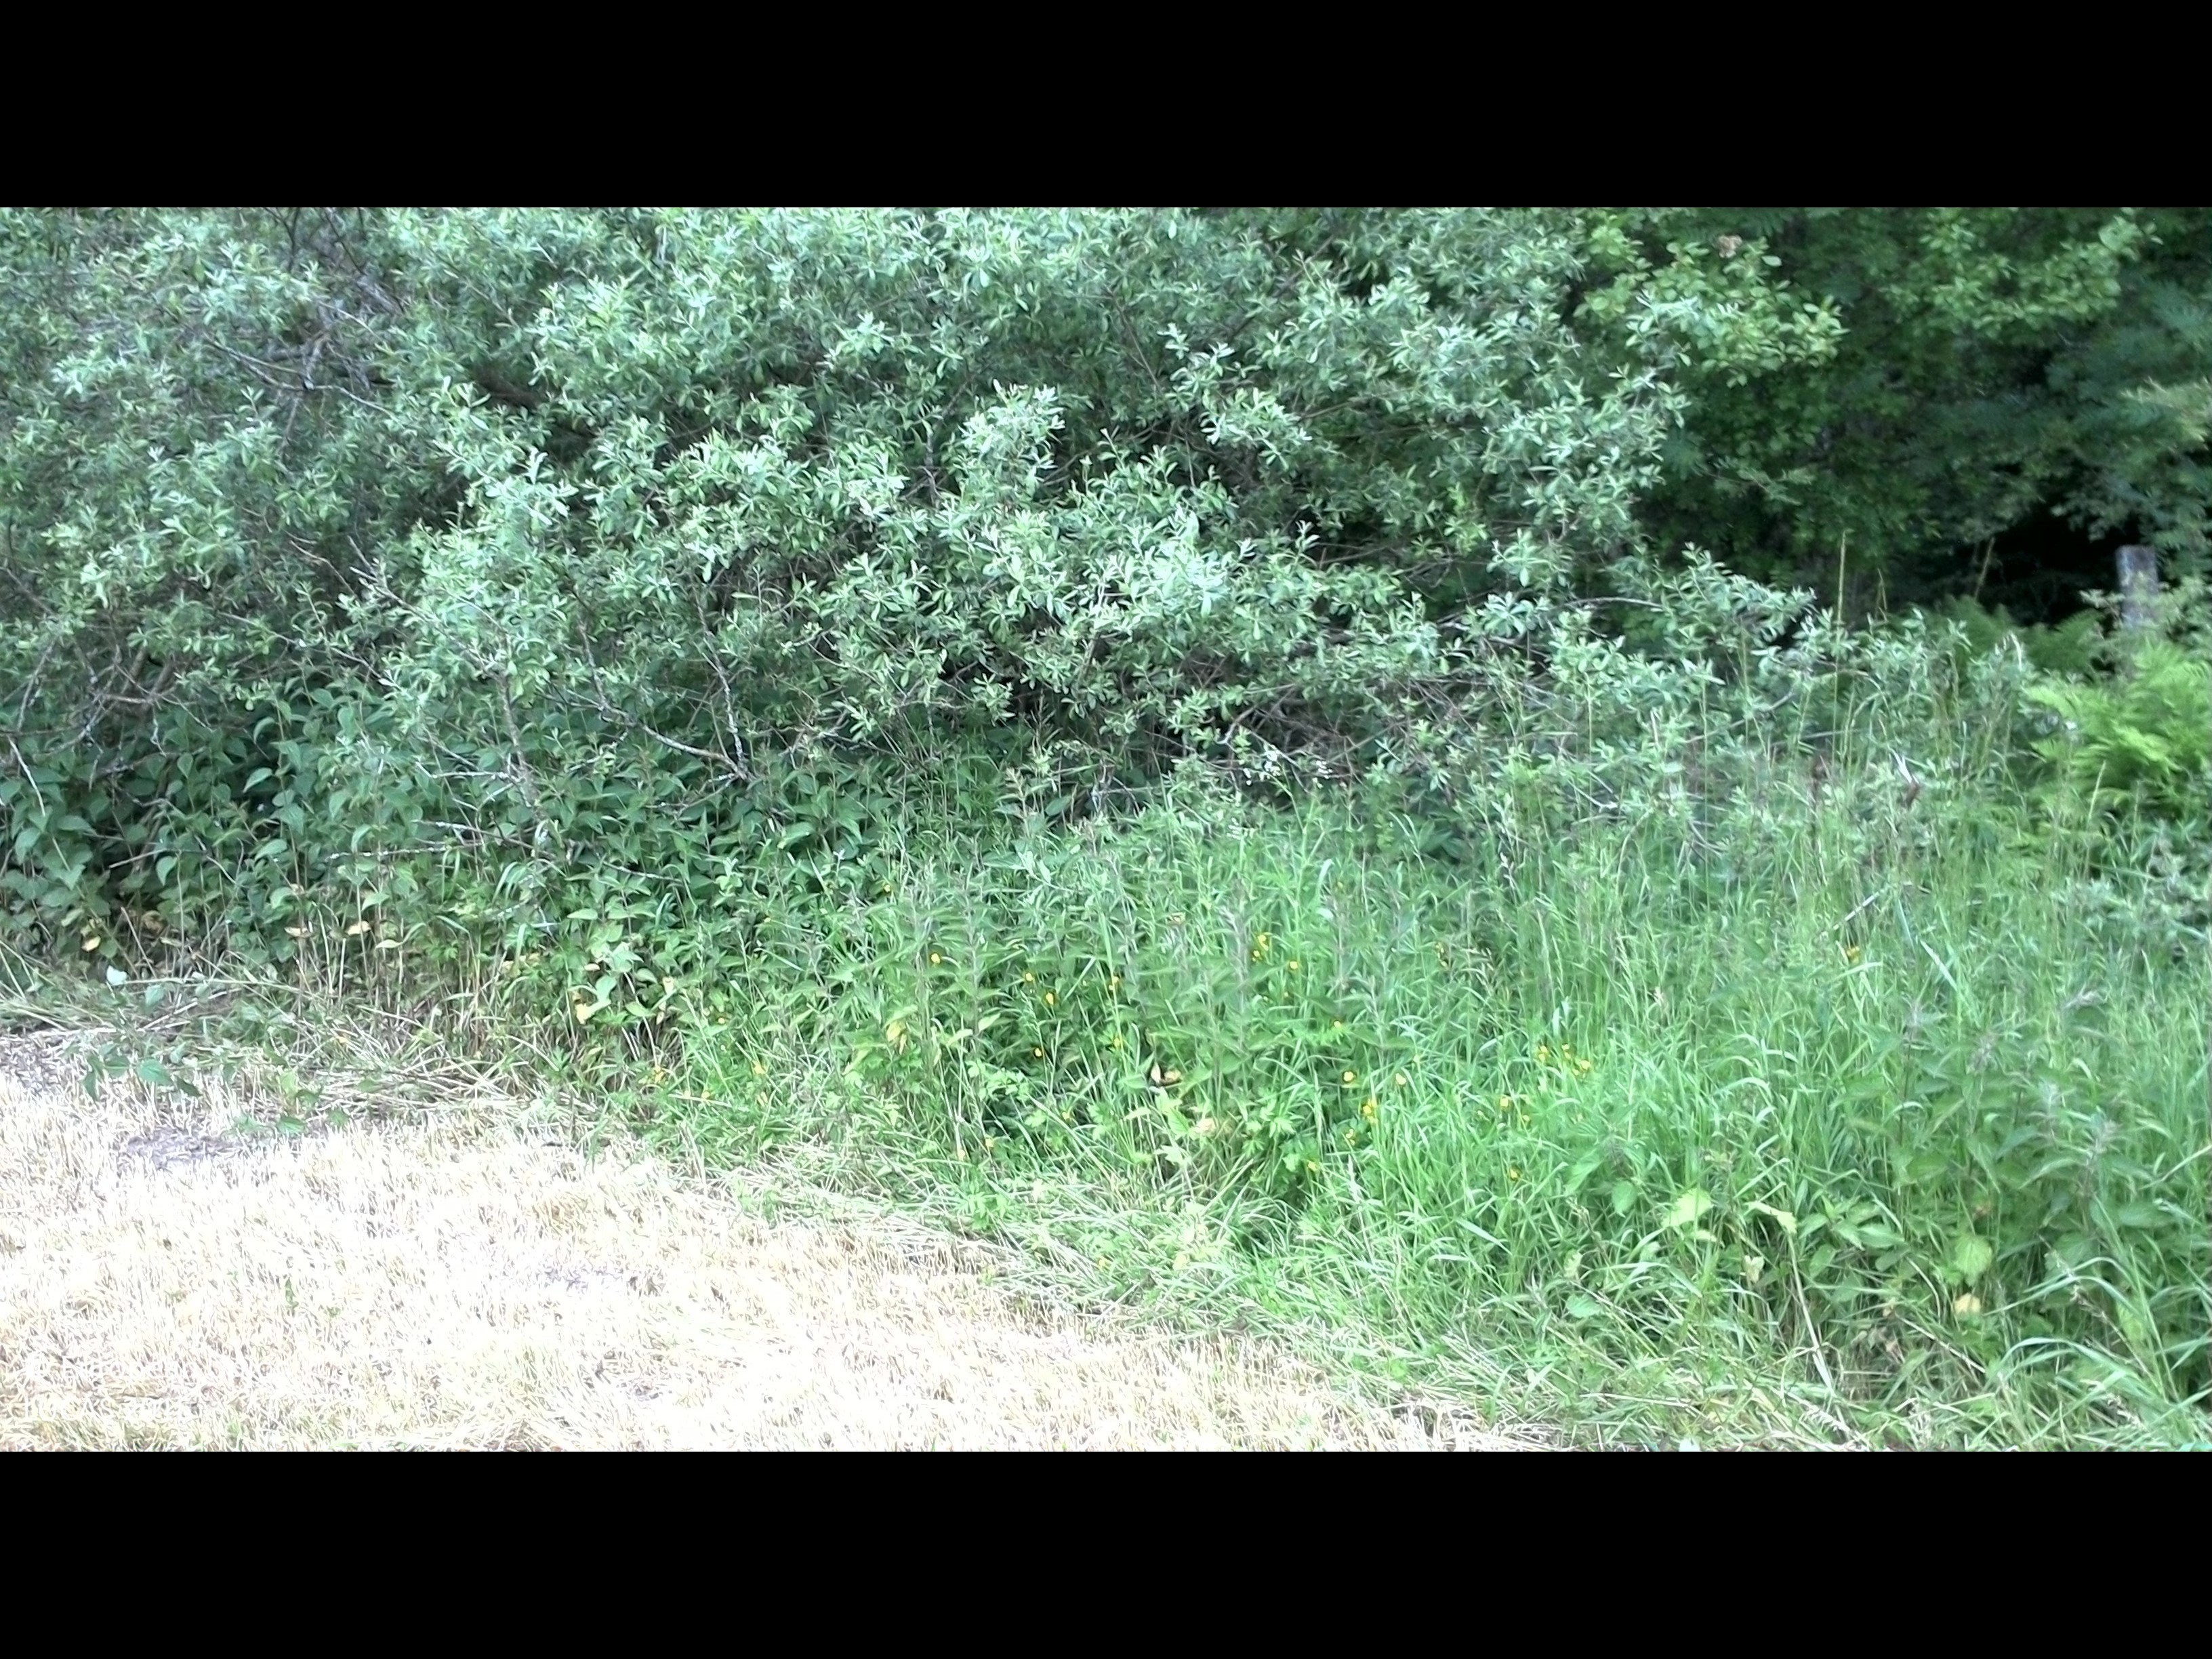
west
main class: Grassland
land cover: Grassland without tree/shrub cover
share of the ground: > 75 %
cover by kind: herbaceous plants 100 %
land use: Agriculture (excluding fallow land and kitchen gardens)
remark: Harvested field
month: June
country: SE
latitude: 55.8552
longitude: 14.0078
